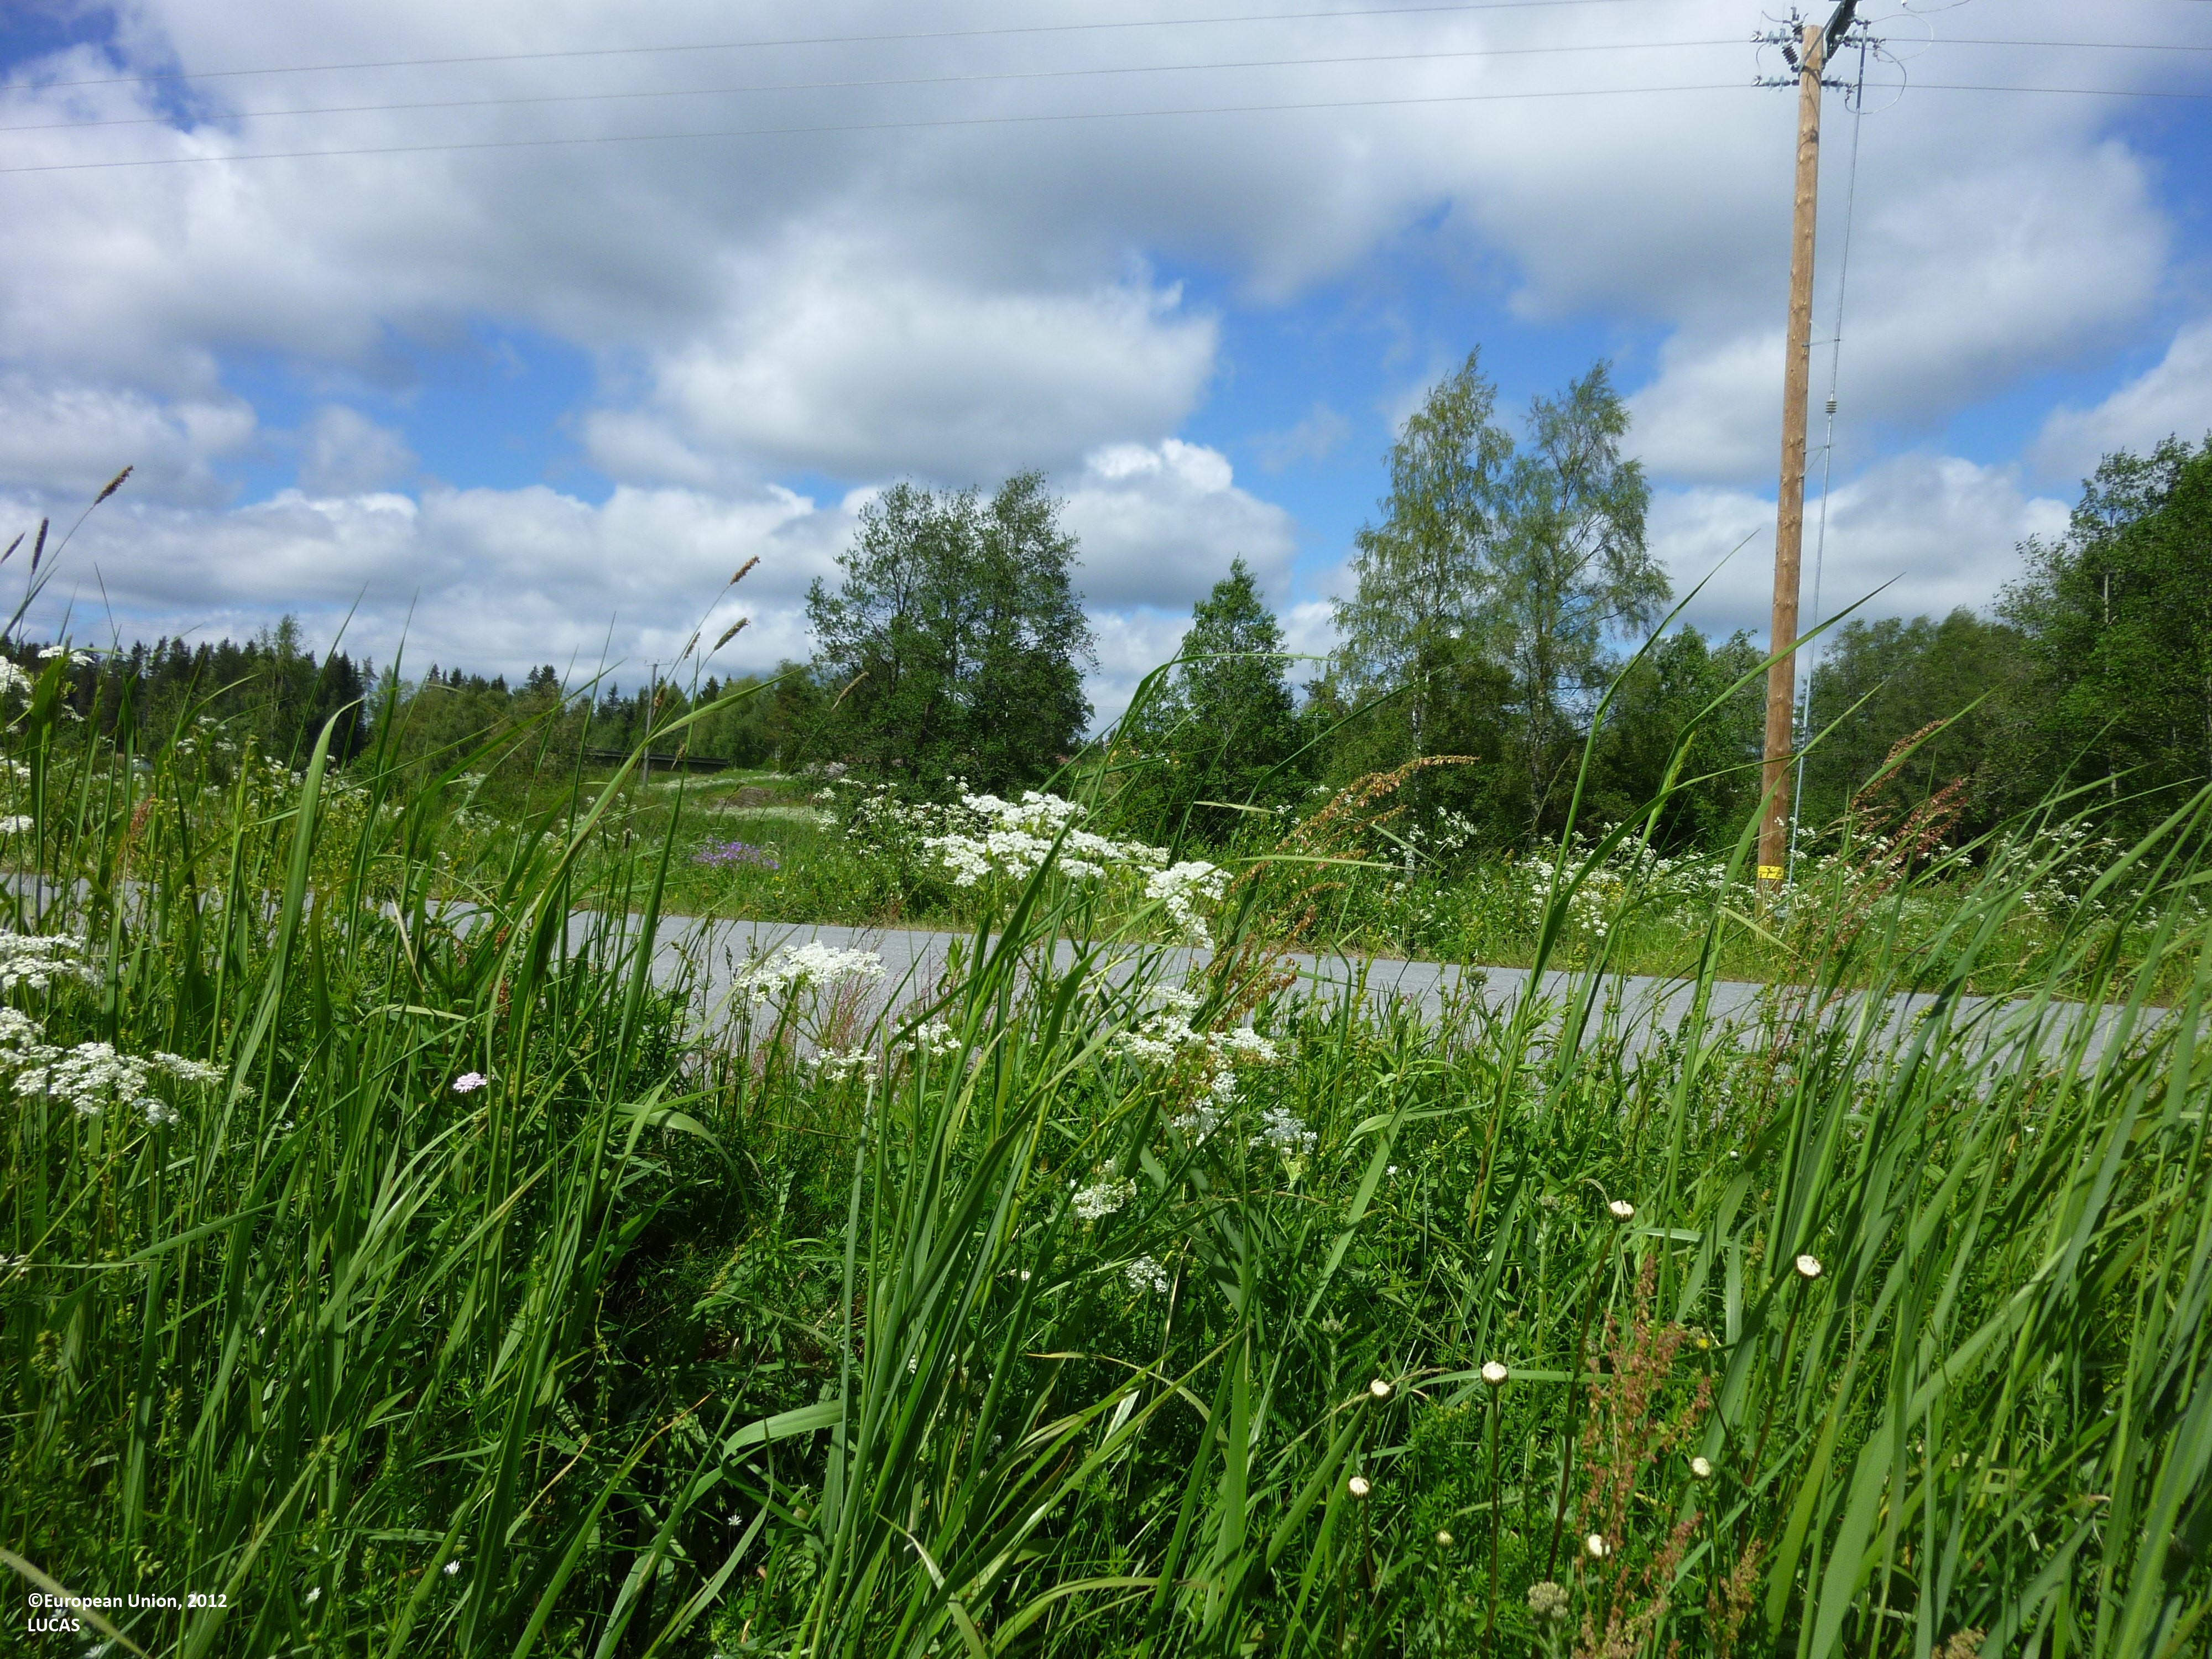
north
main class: Cropland
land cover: Barley
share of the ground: > 75 %
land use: Agriculture (excluding fallow land and kitchen gardens)
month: June
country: FI
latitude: 61.7250
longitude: 22.2641
